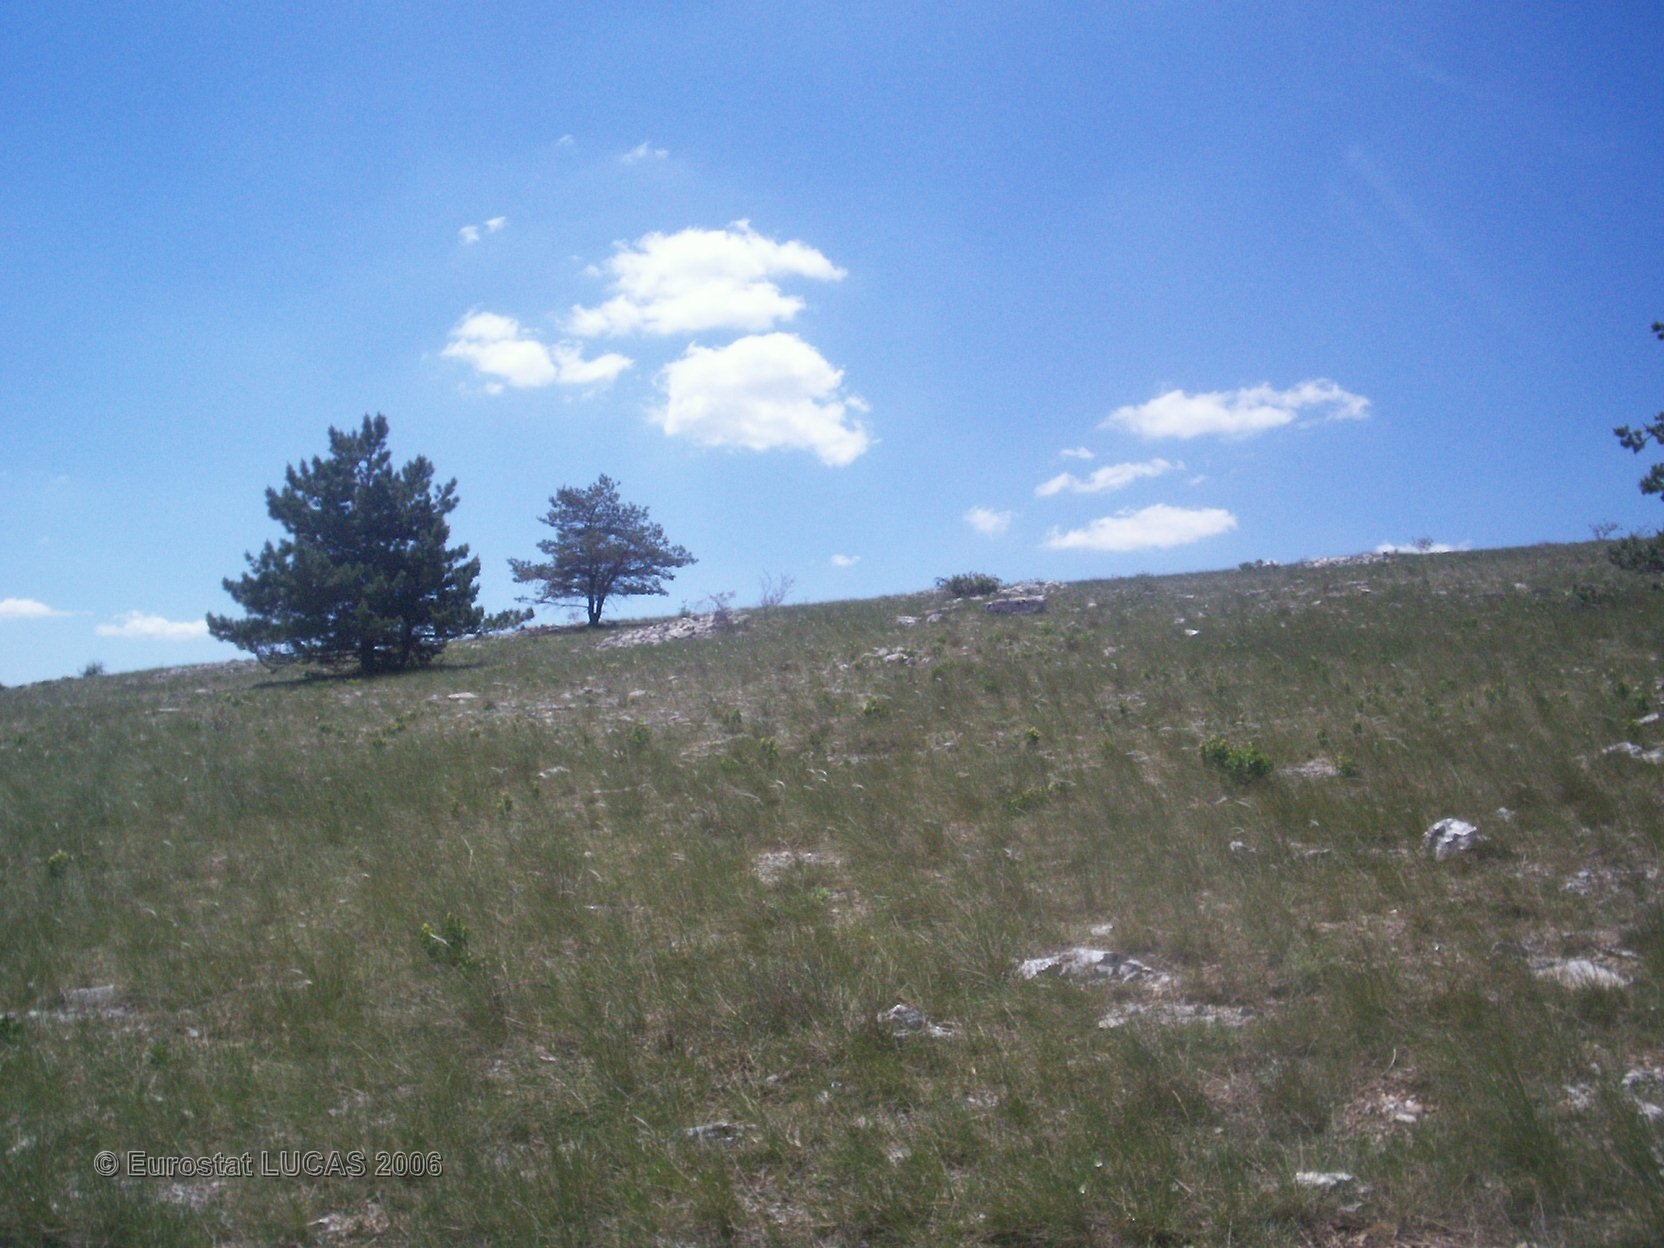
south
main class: Grassland
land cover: Grassland without tree/shrub cover
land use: Agriculture (excluding fallow land and kitchen gardens)
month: June
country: FR
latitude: 44.2134
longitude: 3.4103
